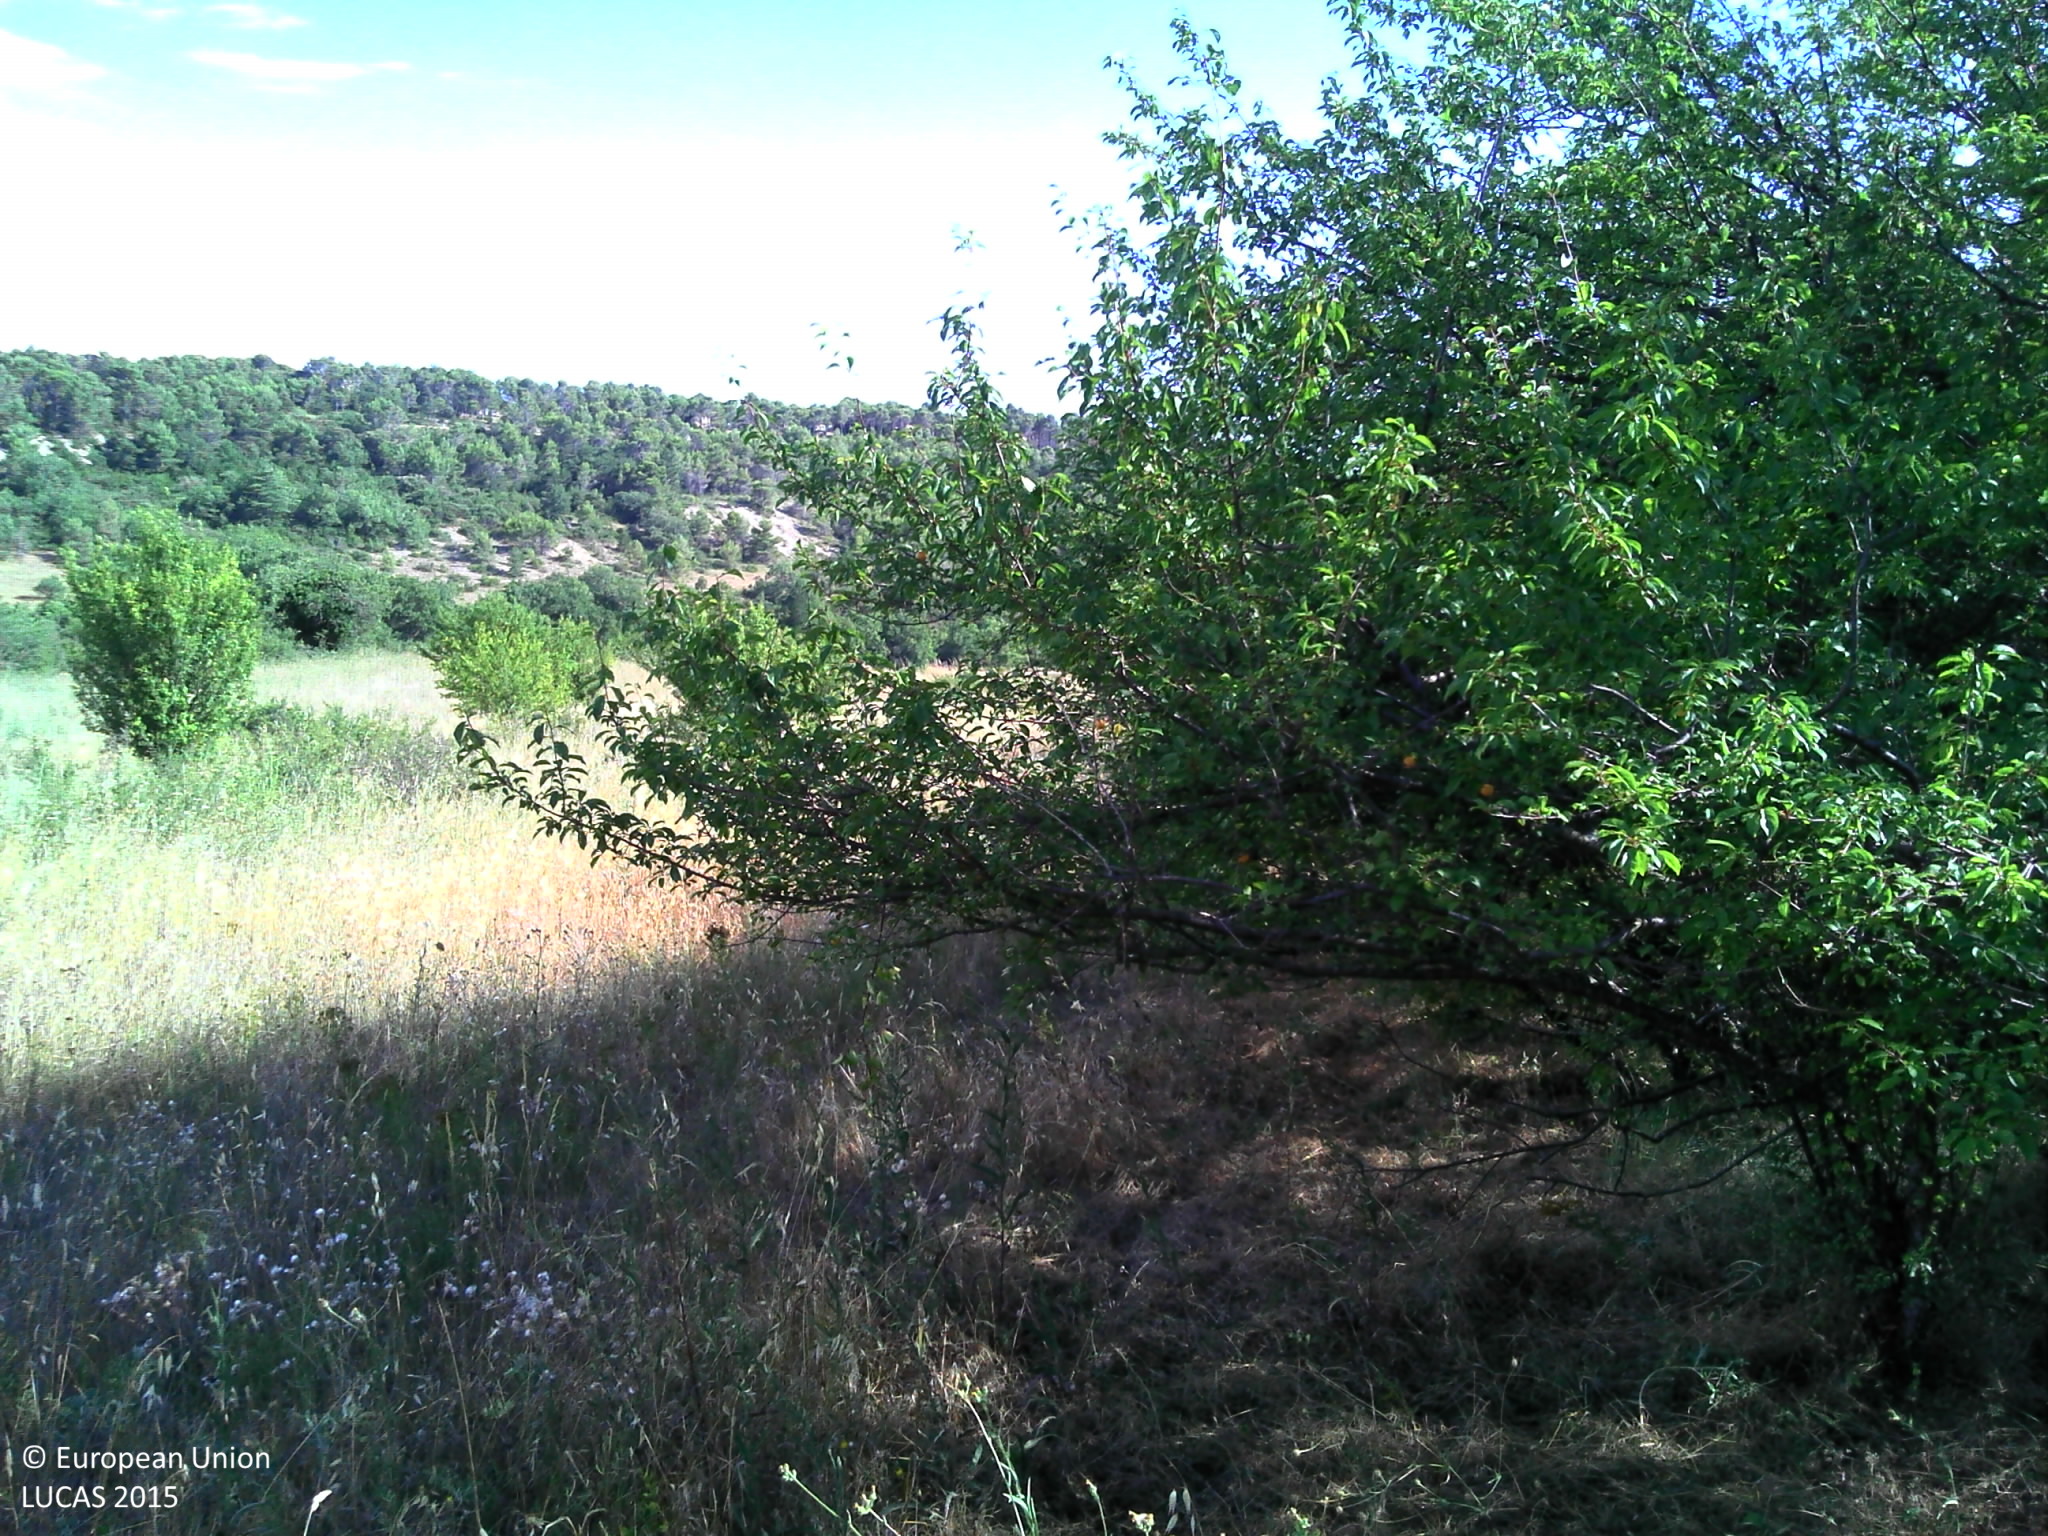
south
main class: Grassland
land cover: Grassland with sparse tree/shrub cover
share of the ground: > 75 %
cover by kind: herbaceous plants 90 %, broadleaved forest trees 5 %, shrubs 5 %
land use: Agriculture (excluding fallow land and kitchen gardens)
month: July
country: FR
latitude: 43.9521
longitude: 5.2360
